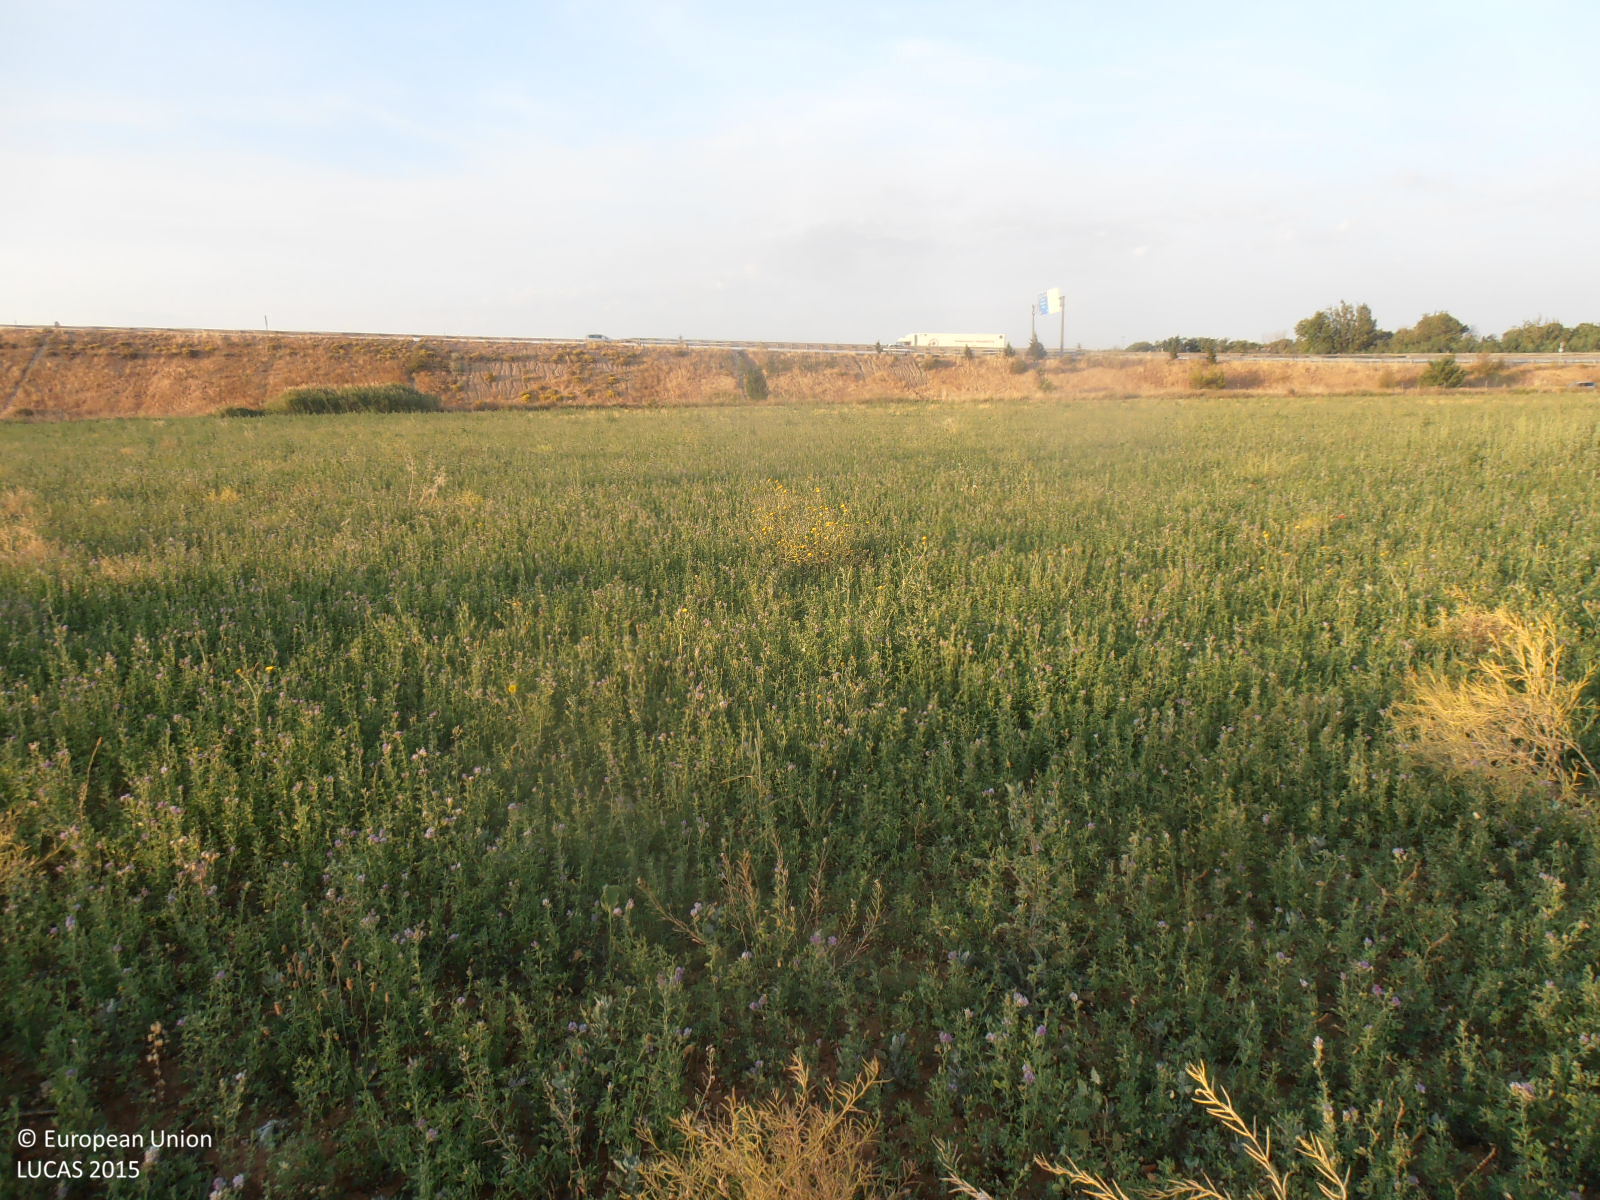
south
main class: Cropland
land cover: Lucerne
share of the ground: > 75 %
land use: Agriculture (excluding fallow land and kitchen gardens)
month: June
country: ES
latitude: 41.6922
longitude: -0.9686
